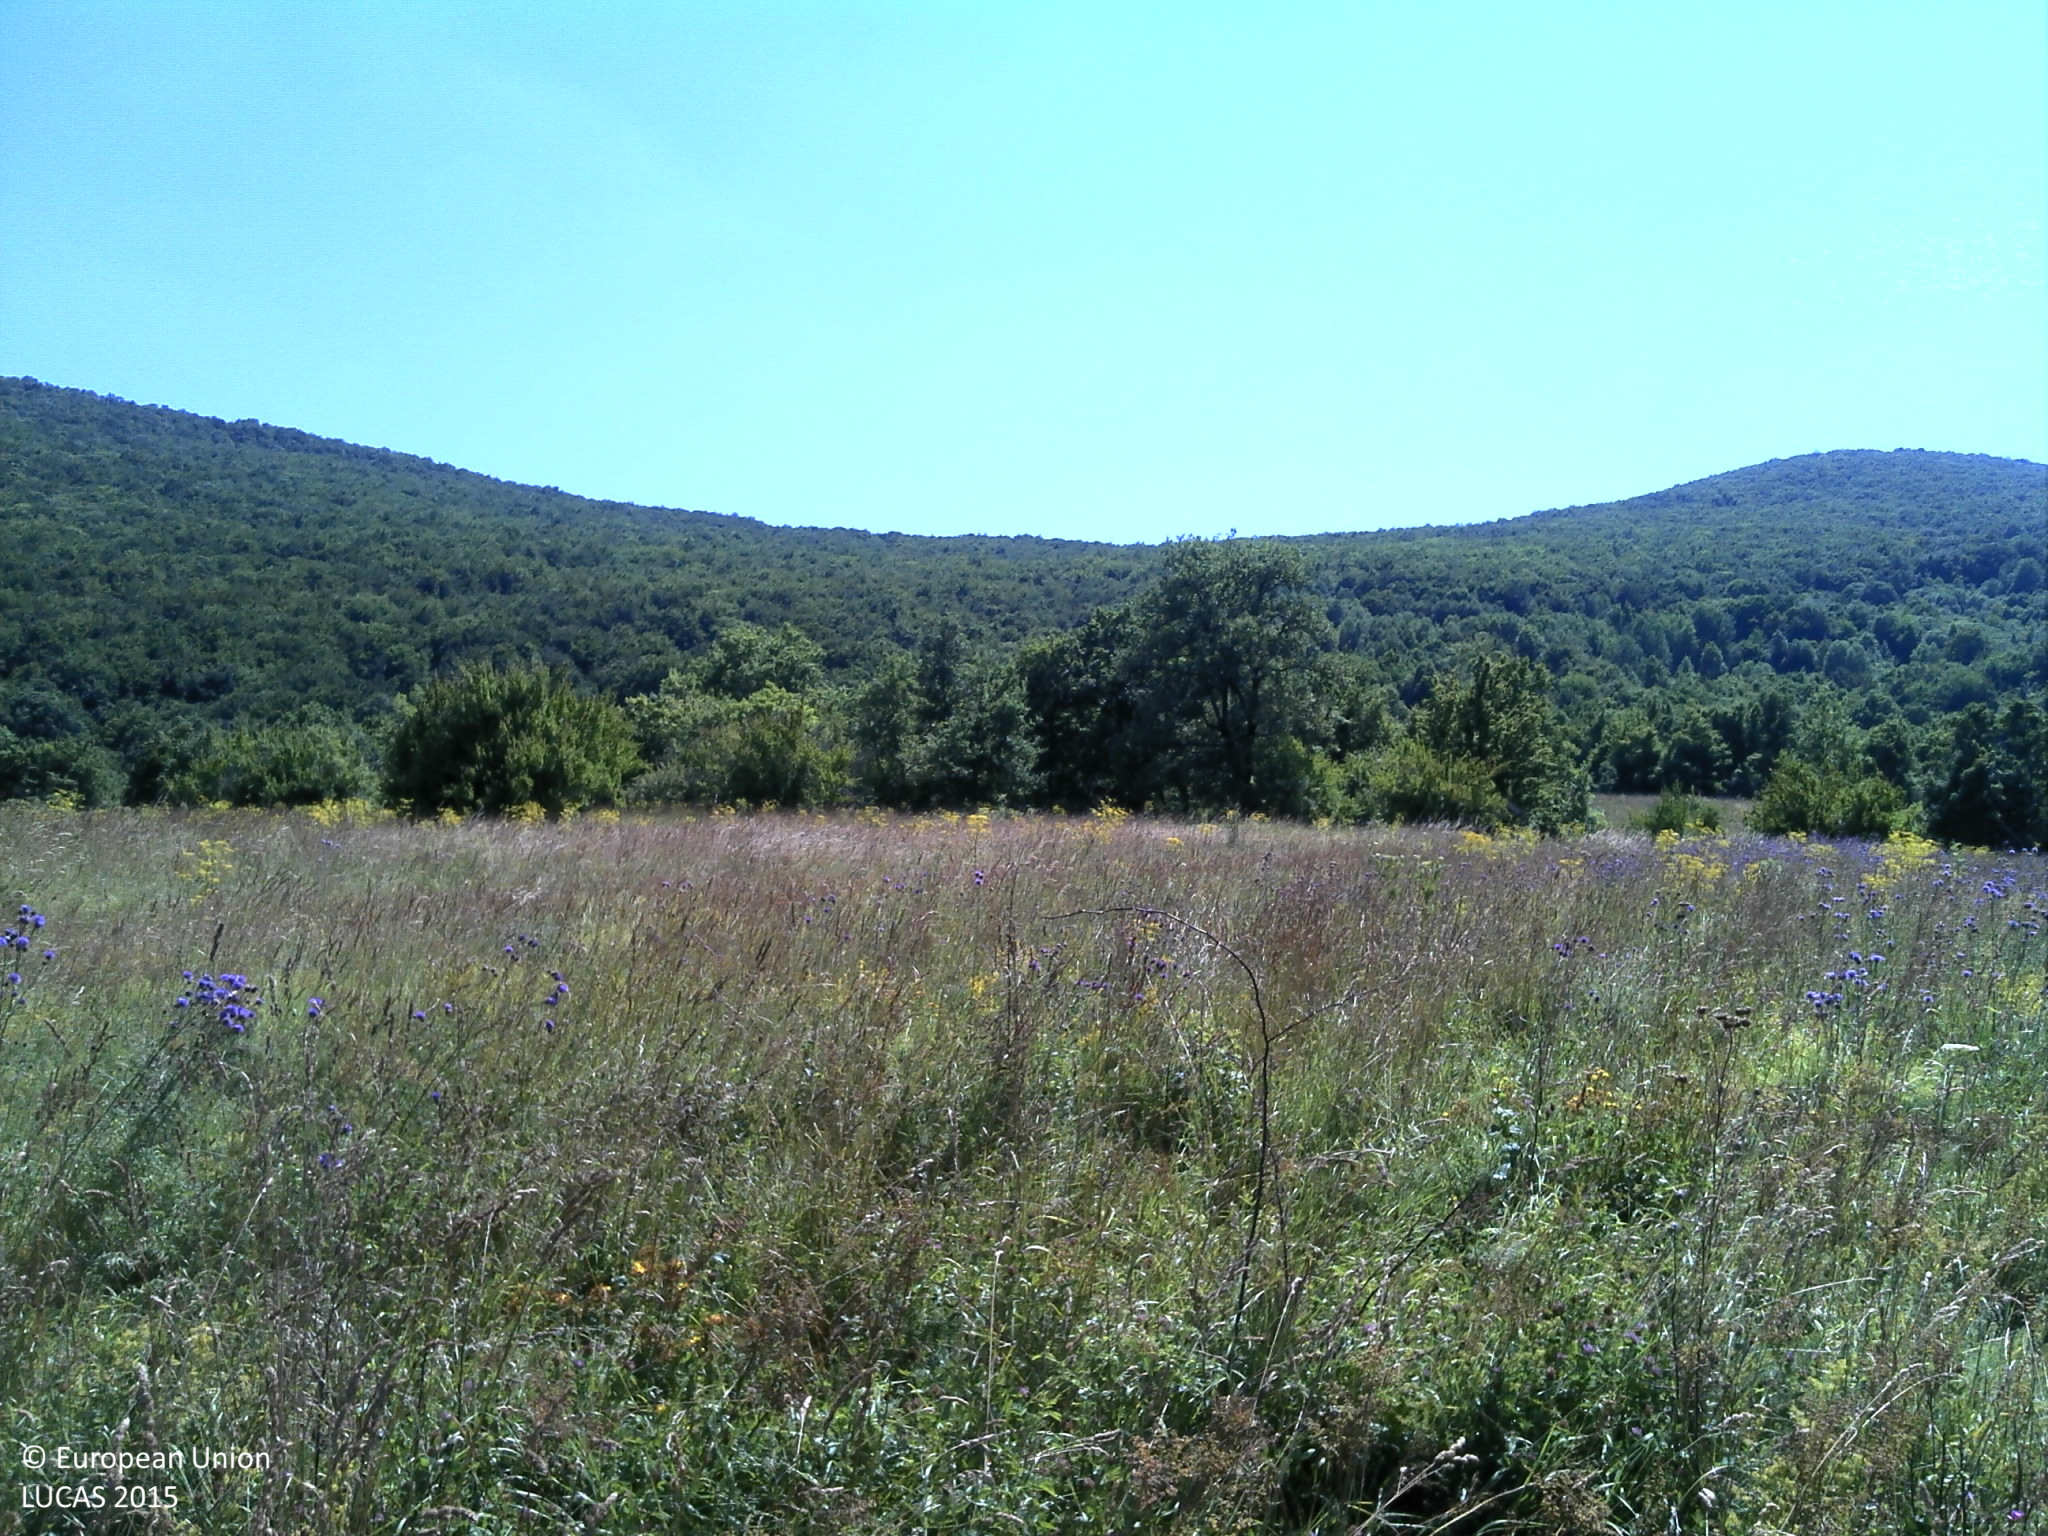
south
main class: Grassland
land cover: Grassland without tree/shrub cover
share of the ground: > 75 %
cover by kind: herbaceous plants 95 %, shrubs 5 %
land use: Semi-natural and natural areas not in use
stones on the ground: < 10 %
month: July
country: HR
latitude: 44.9247
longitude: 15.2014
